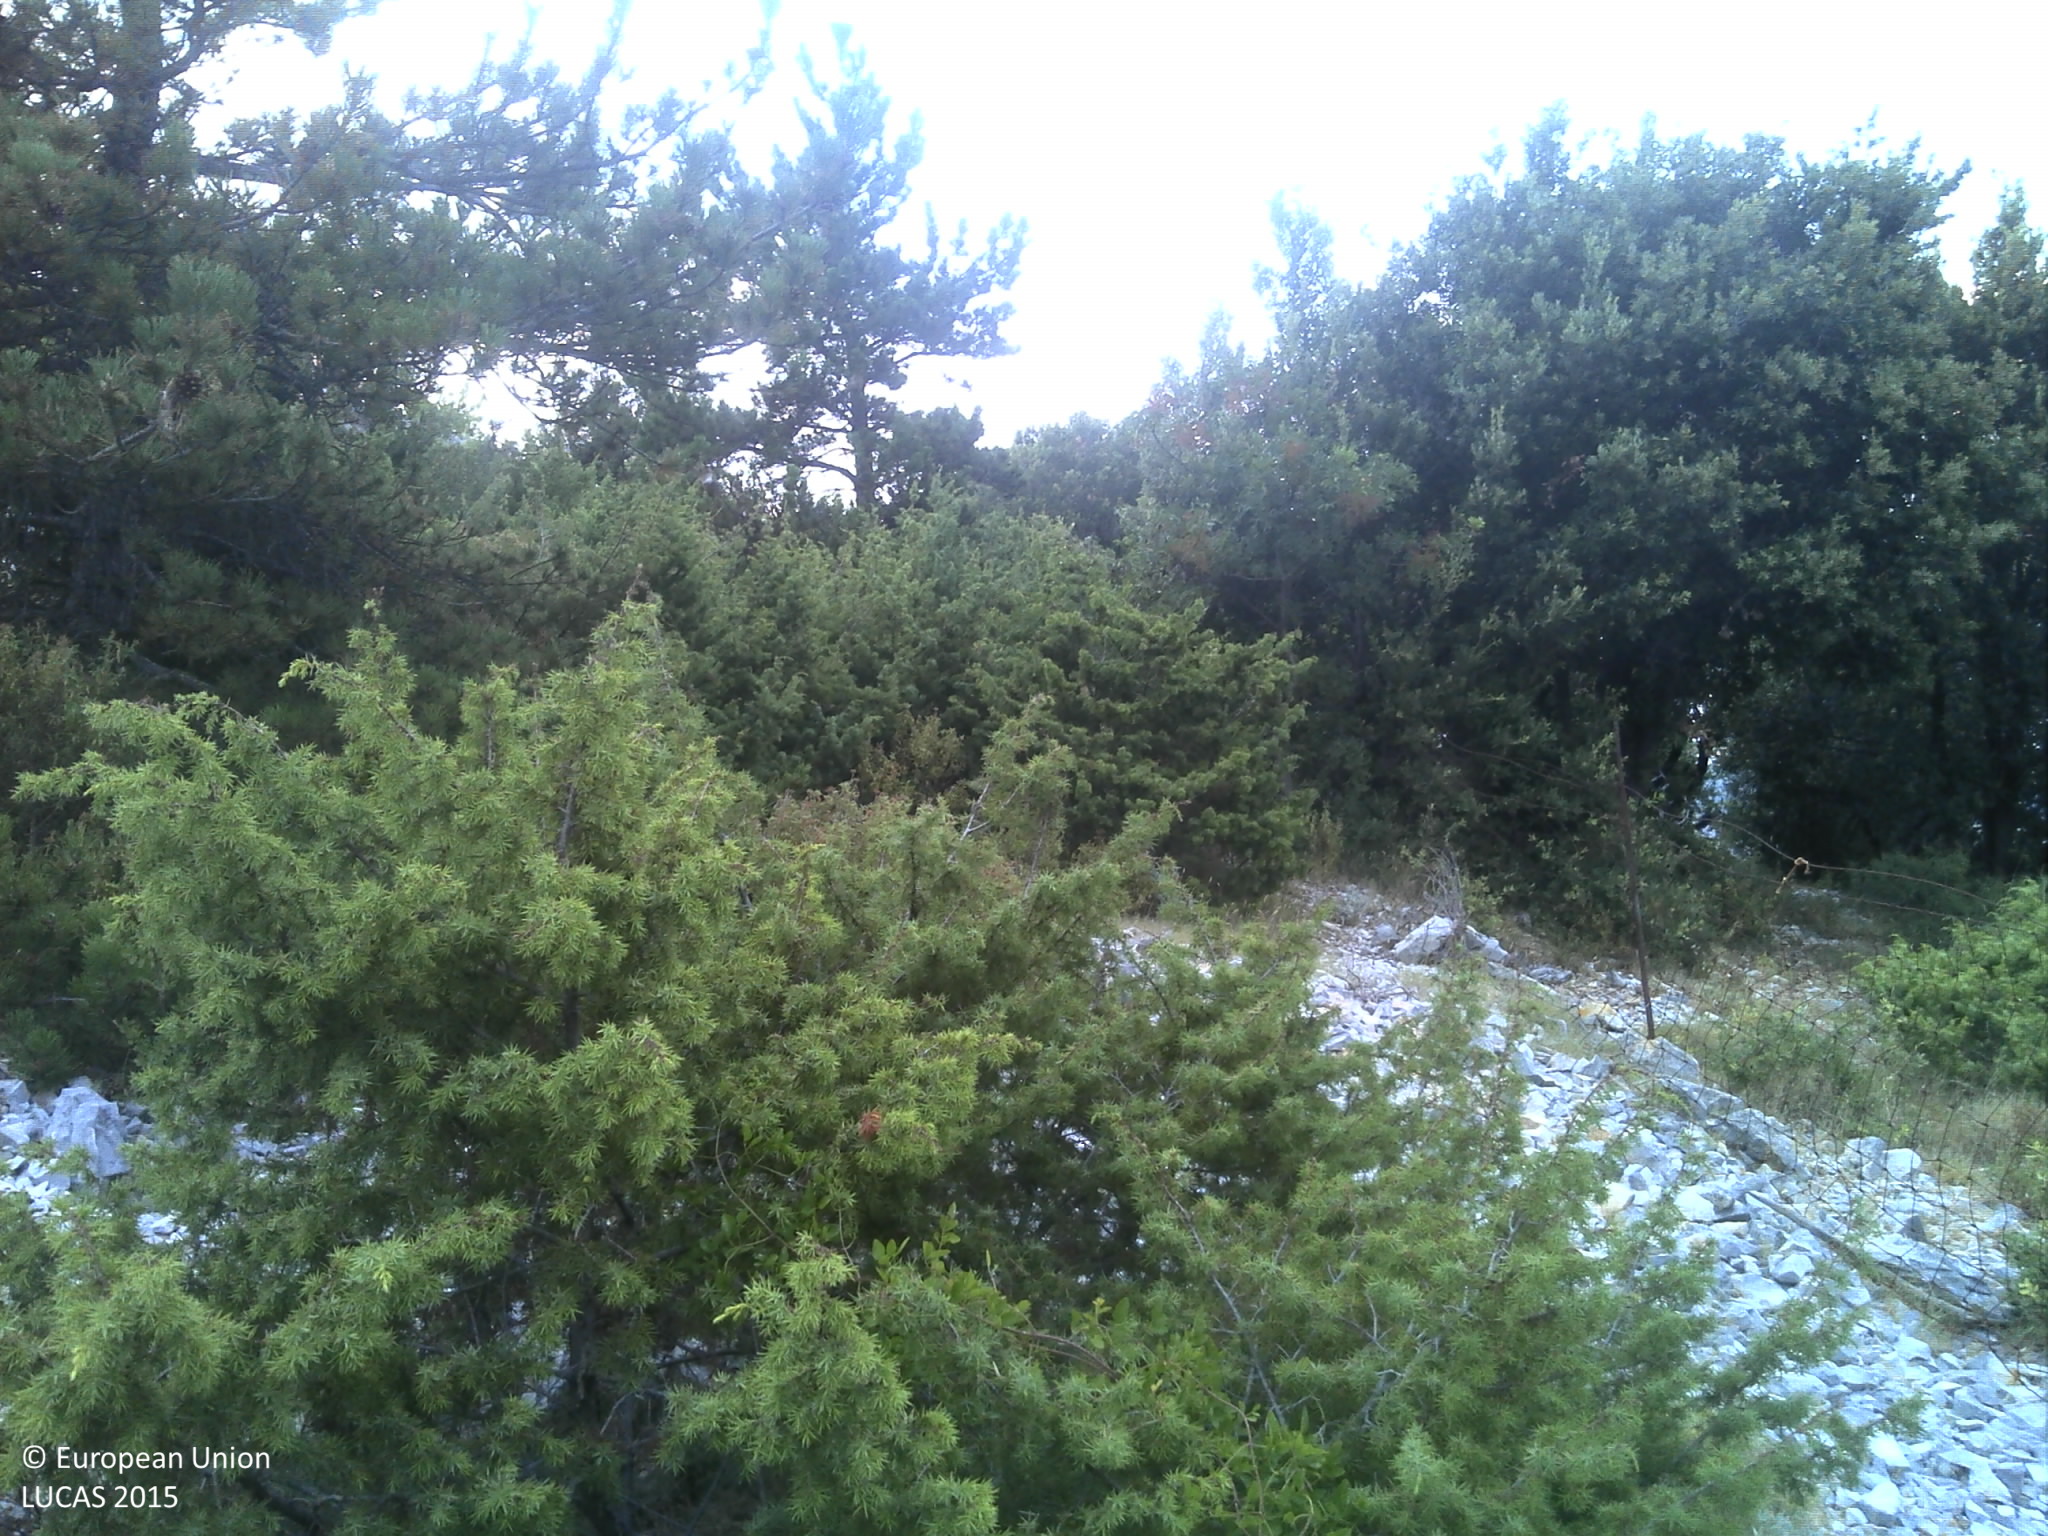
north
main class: Shrubland
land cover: Shrubland with sparse tree cover
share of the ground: > 75 %
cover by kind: shrubs 50 %, unconsolidated bare surface 25 %, consolidated bare surface 15 %, coniferous forest trees 5 %, herbaceous plants 5 %
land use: Semi-natural and natural areas not in use
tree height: < 5 m
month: July
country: HR
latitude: 43.3268
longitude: 16.5880
